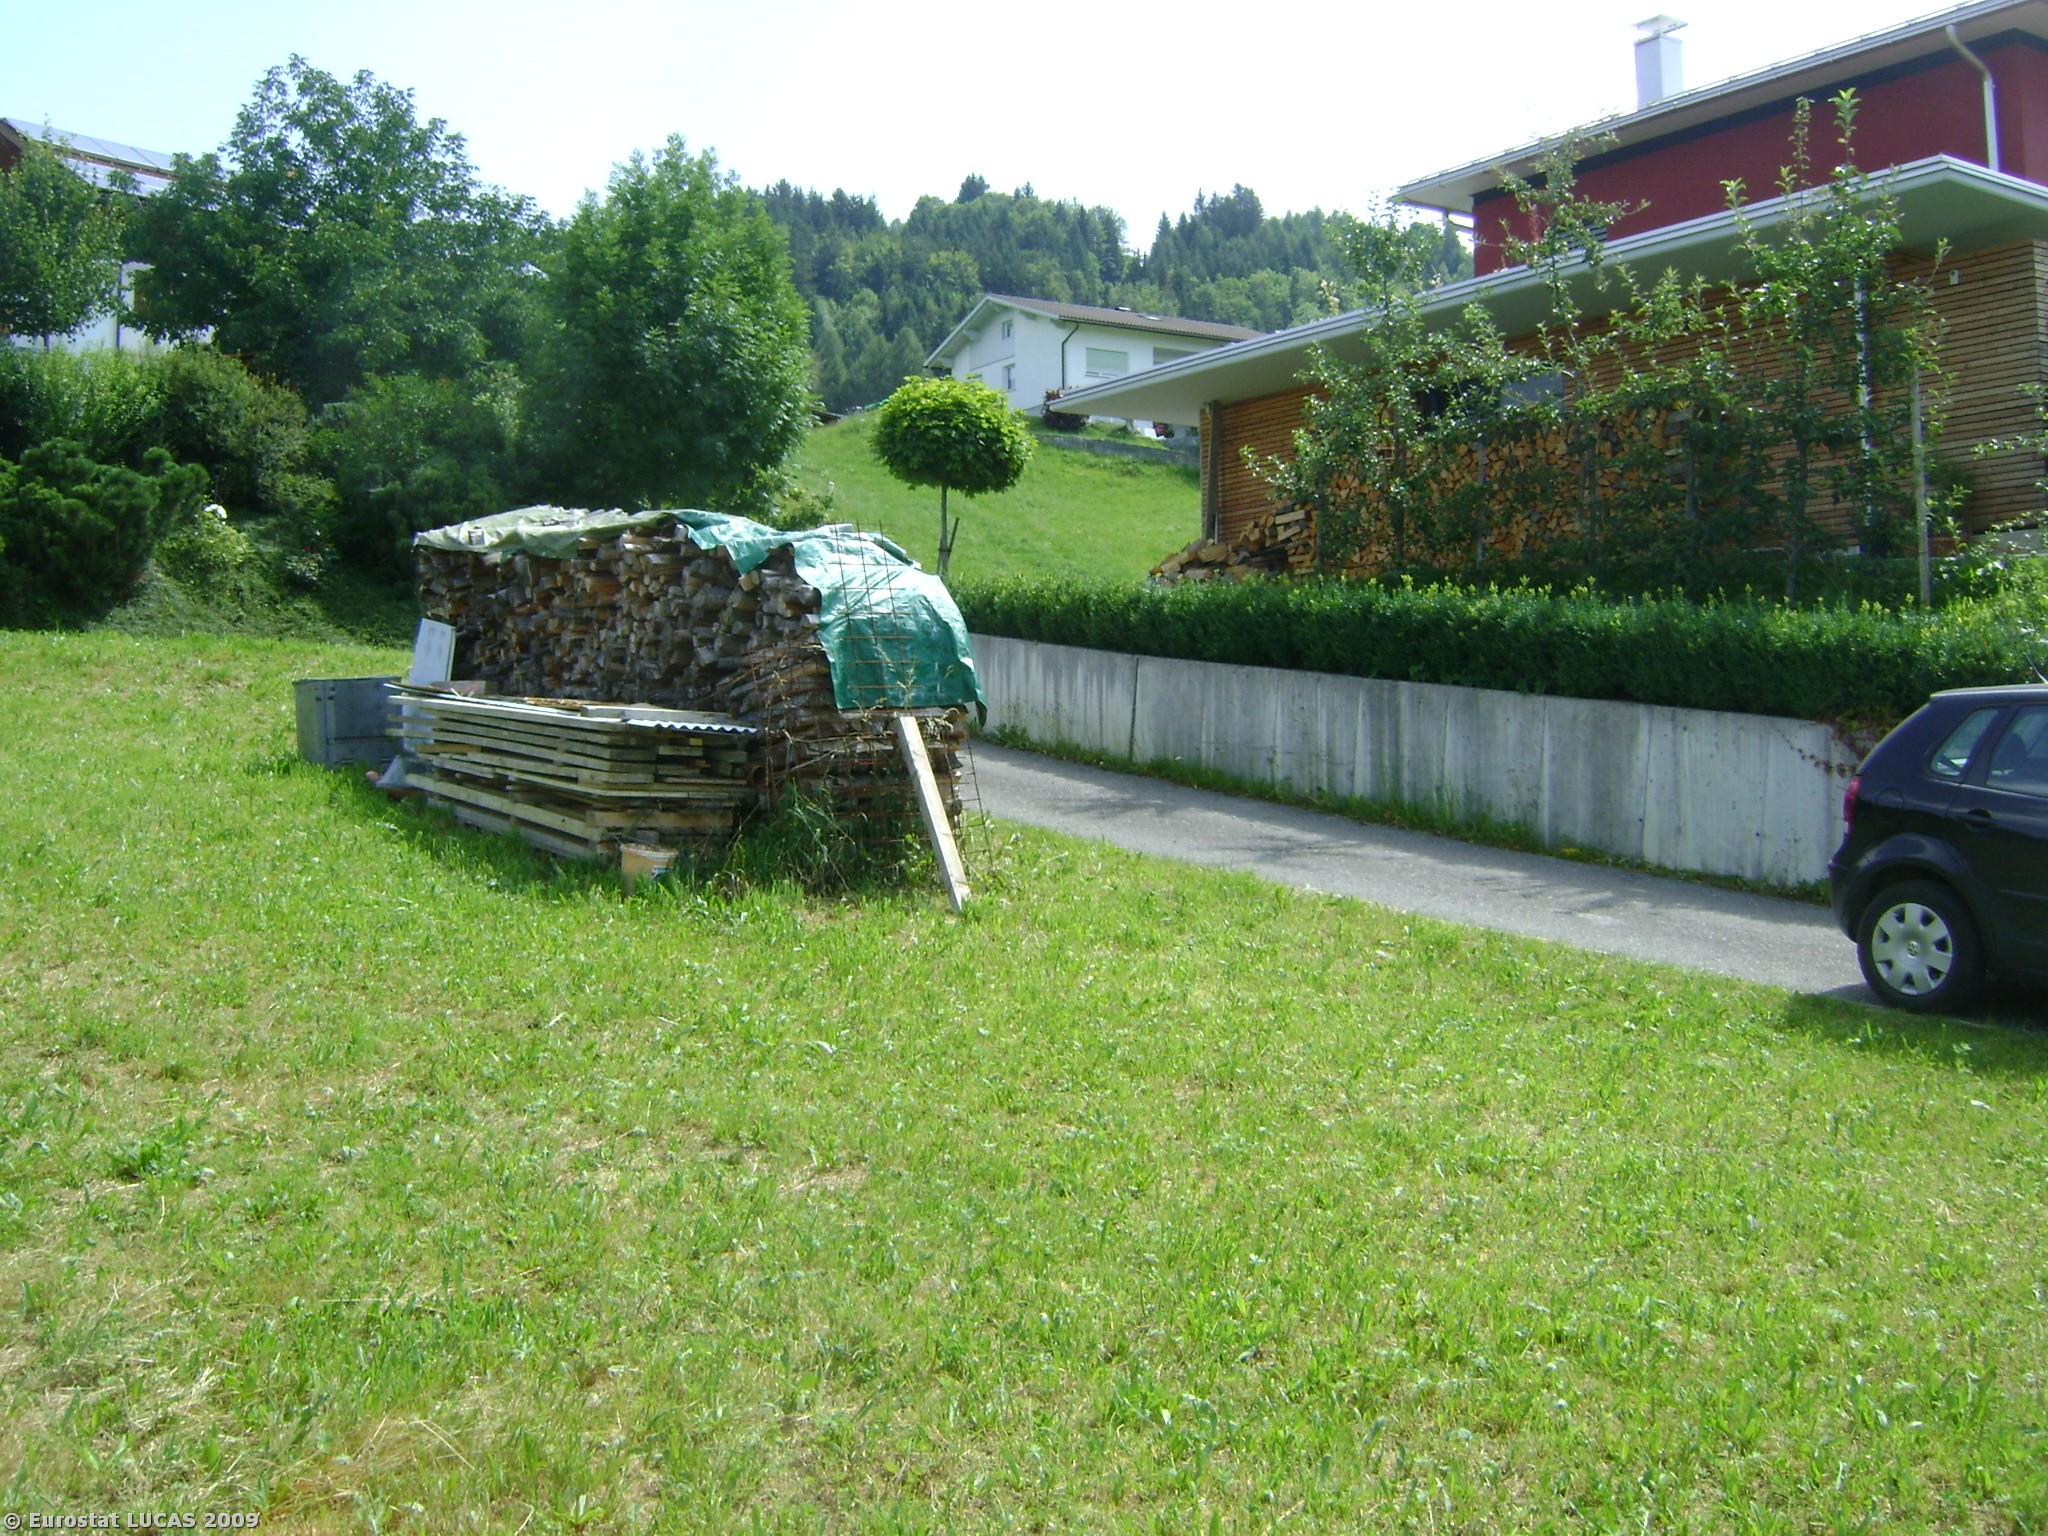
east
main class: Grassland
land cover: Grassland without tree/shrub cover
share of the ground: > 75 %
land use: Agriculture (excluding fallow land and kitchen gardens)
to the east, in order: Grassland without tree/shrub cover; Tracks; Artificial constructions in urban areas; Paved roads, cycling and walking lanes; Grassland without tree/shrub cover; Dry stone walls; Artificial constructions in urban areas; Grassland without tree/shrub cover; Artificial constructions in urban areas
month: July
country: AT
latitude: 47.2511
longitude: 9.6700
